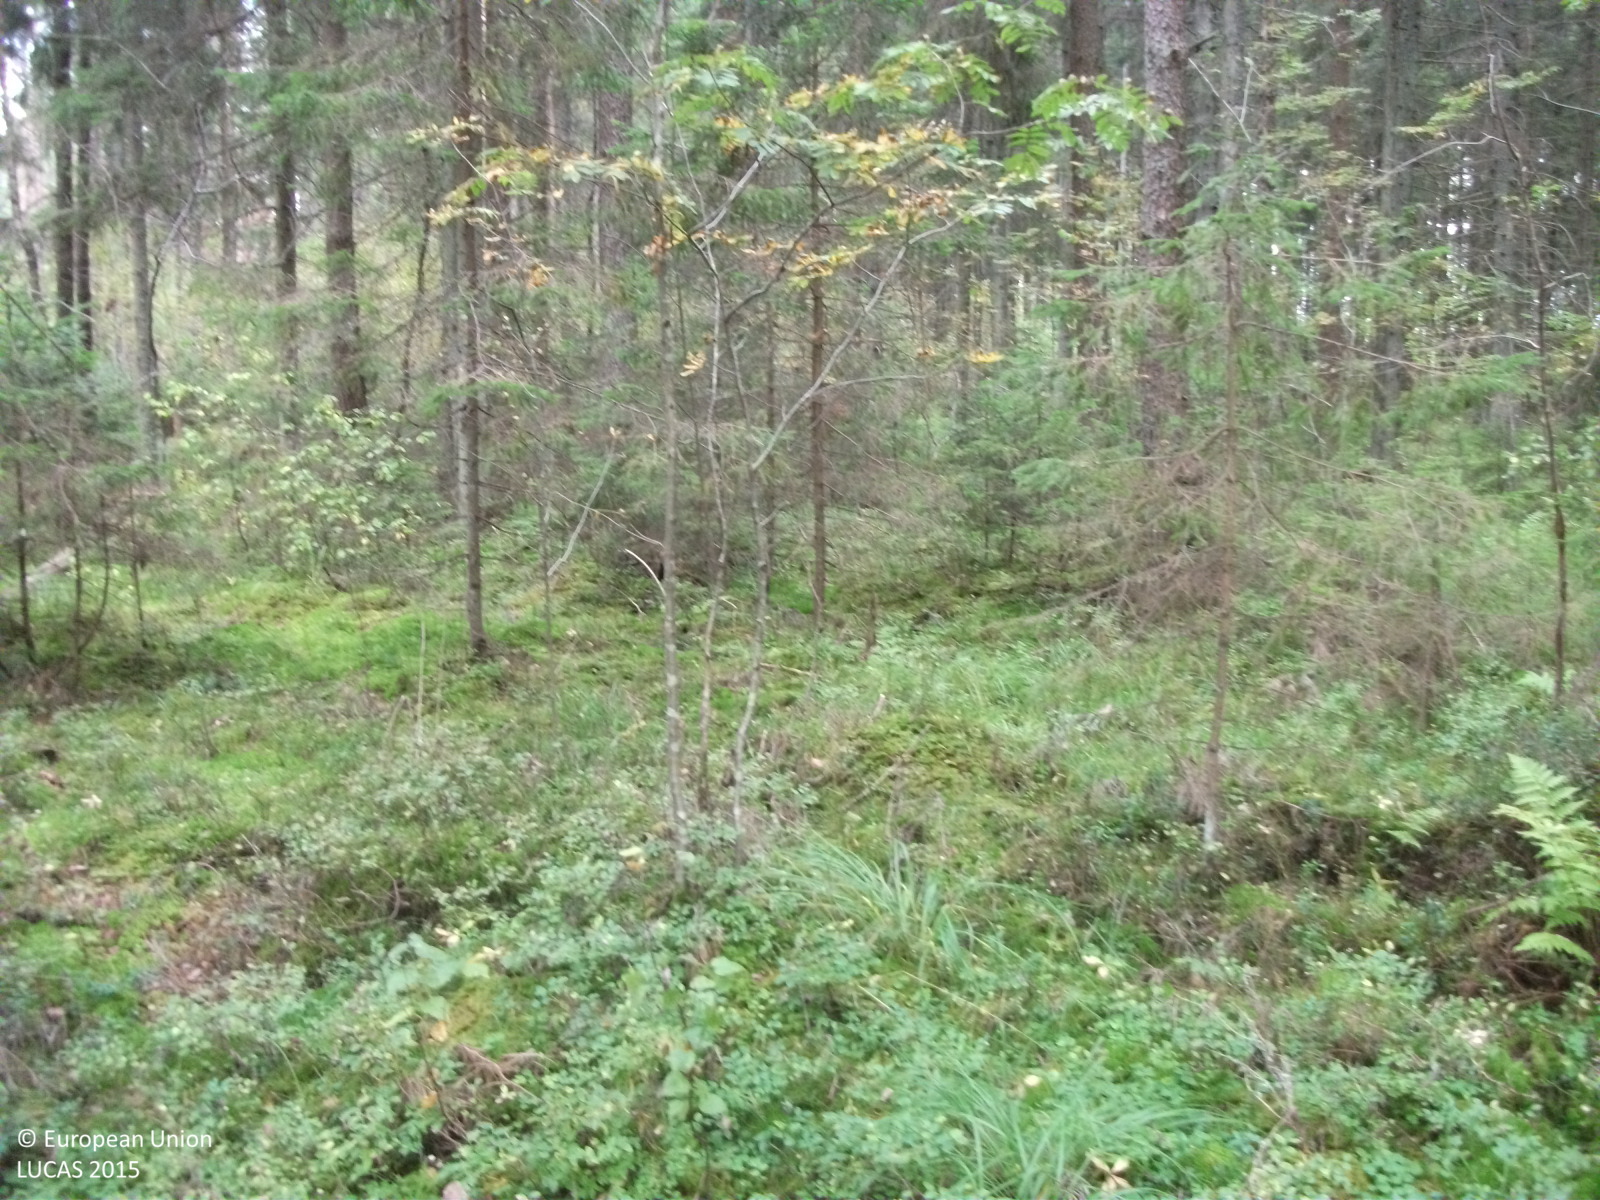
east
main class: Woodland
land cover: Other coniferous woodland
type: hemiboreal forest and nemoral coniferous forest and mixed broadleaved-coniferous forest
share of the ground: > 75 %
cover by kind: coniferous forest trees 80 %, herbaceous plants 10 %, broadleaved forest trees 5 %, lichens and mosses 5 %
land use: Forestry
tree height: > 5 m
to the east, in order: Other coniferous woodland; Spruce dominated coniferous woodland; Spruce dominated mixed woodland; Pine dominated mixed woodland; Other coniferous woodland
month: September
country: LV
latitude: 57.8660
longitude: 24.6736
